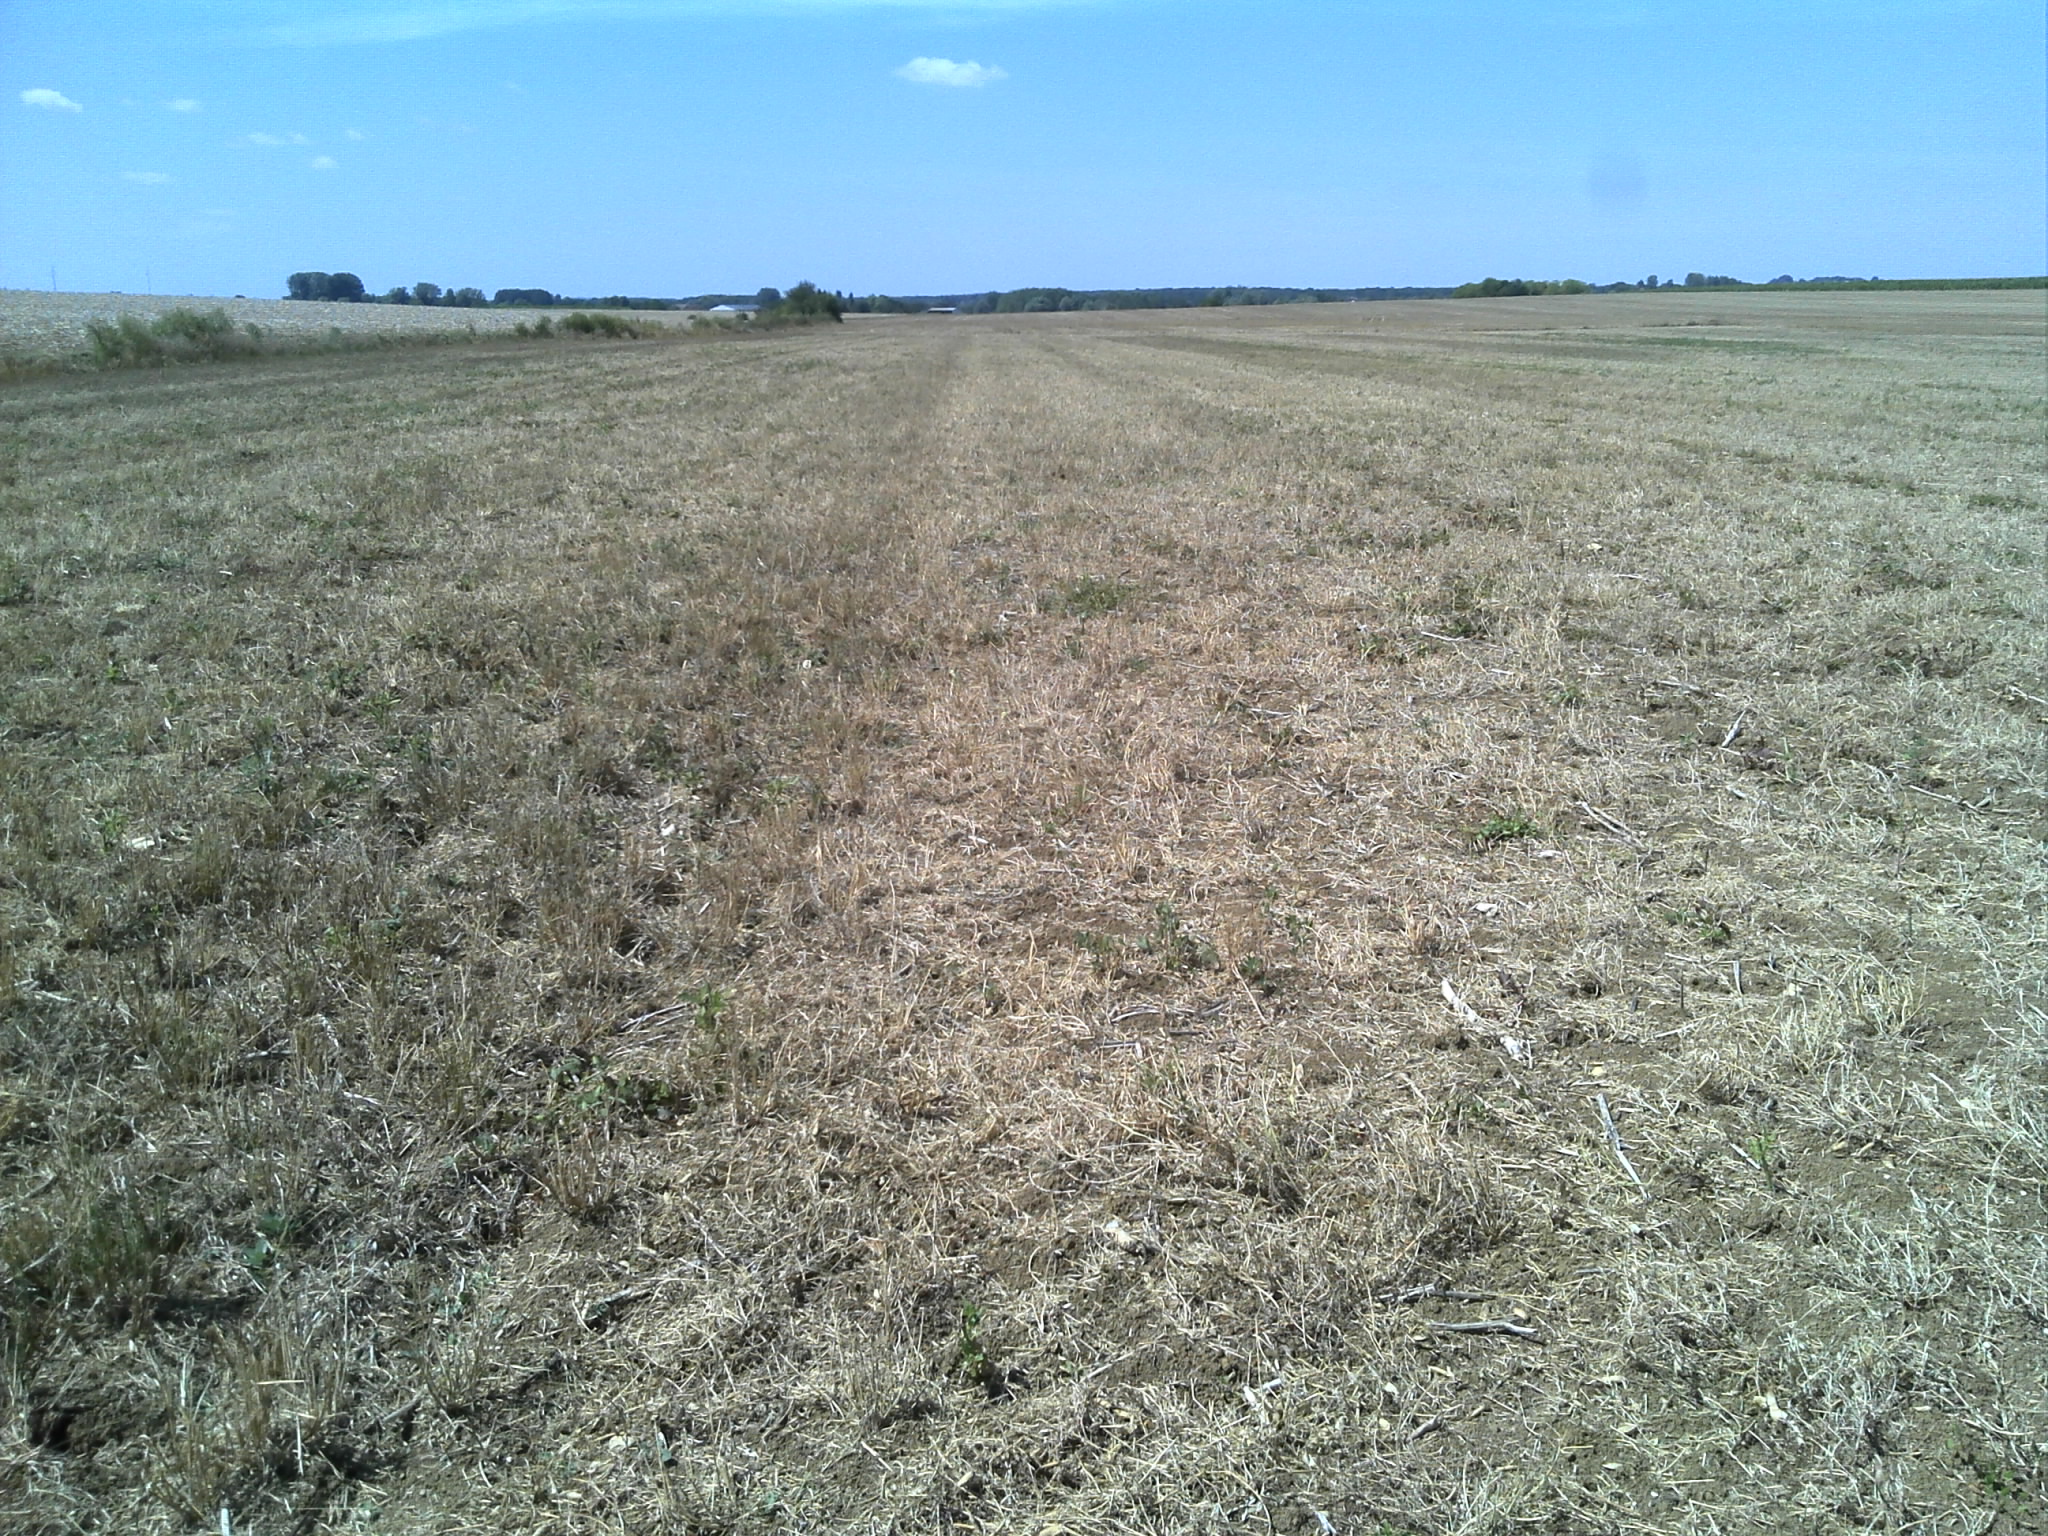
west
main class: Cropland
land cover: Dry pulses
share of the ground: 25 - 50 %
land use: Agriculture (excluding fallow land and kitchen gardens)
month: August
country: FR
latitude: 46.9507
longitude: 1.4605
